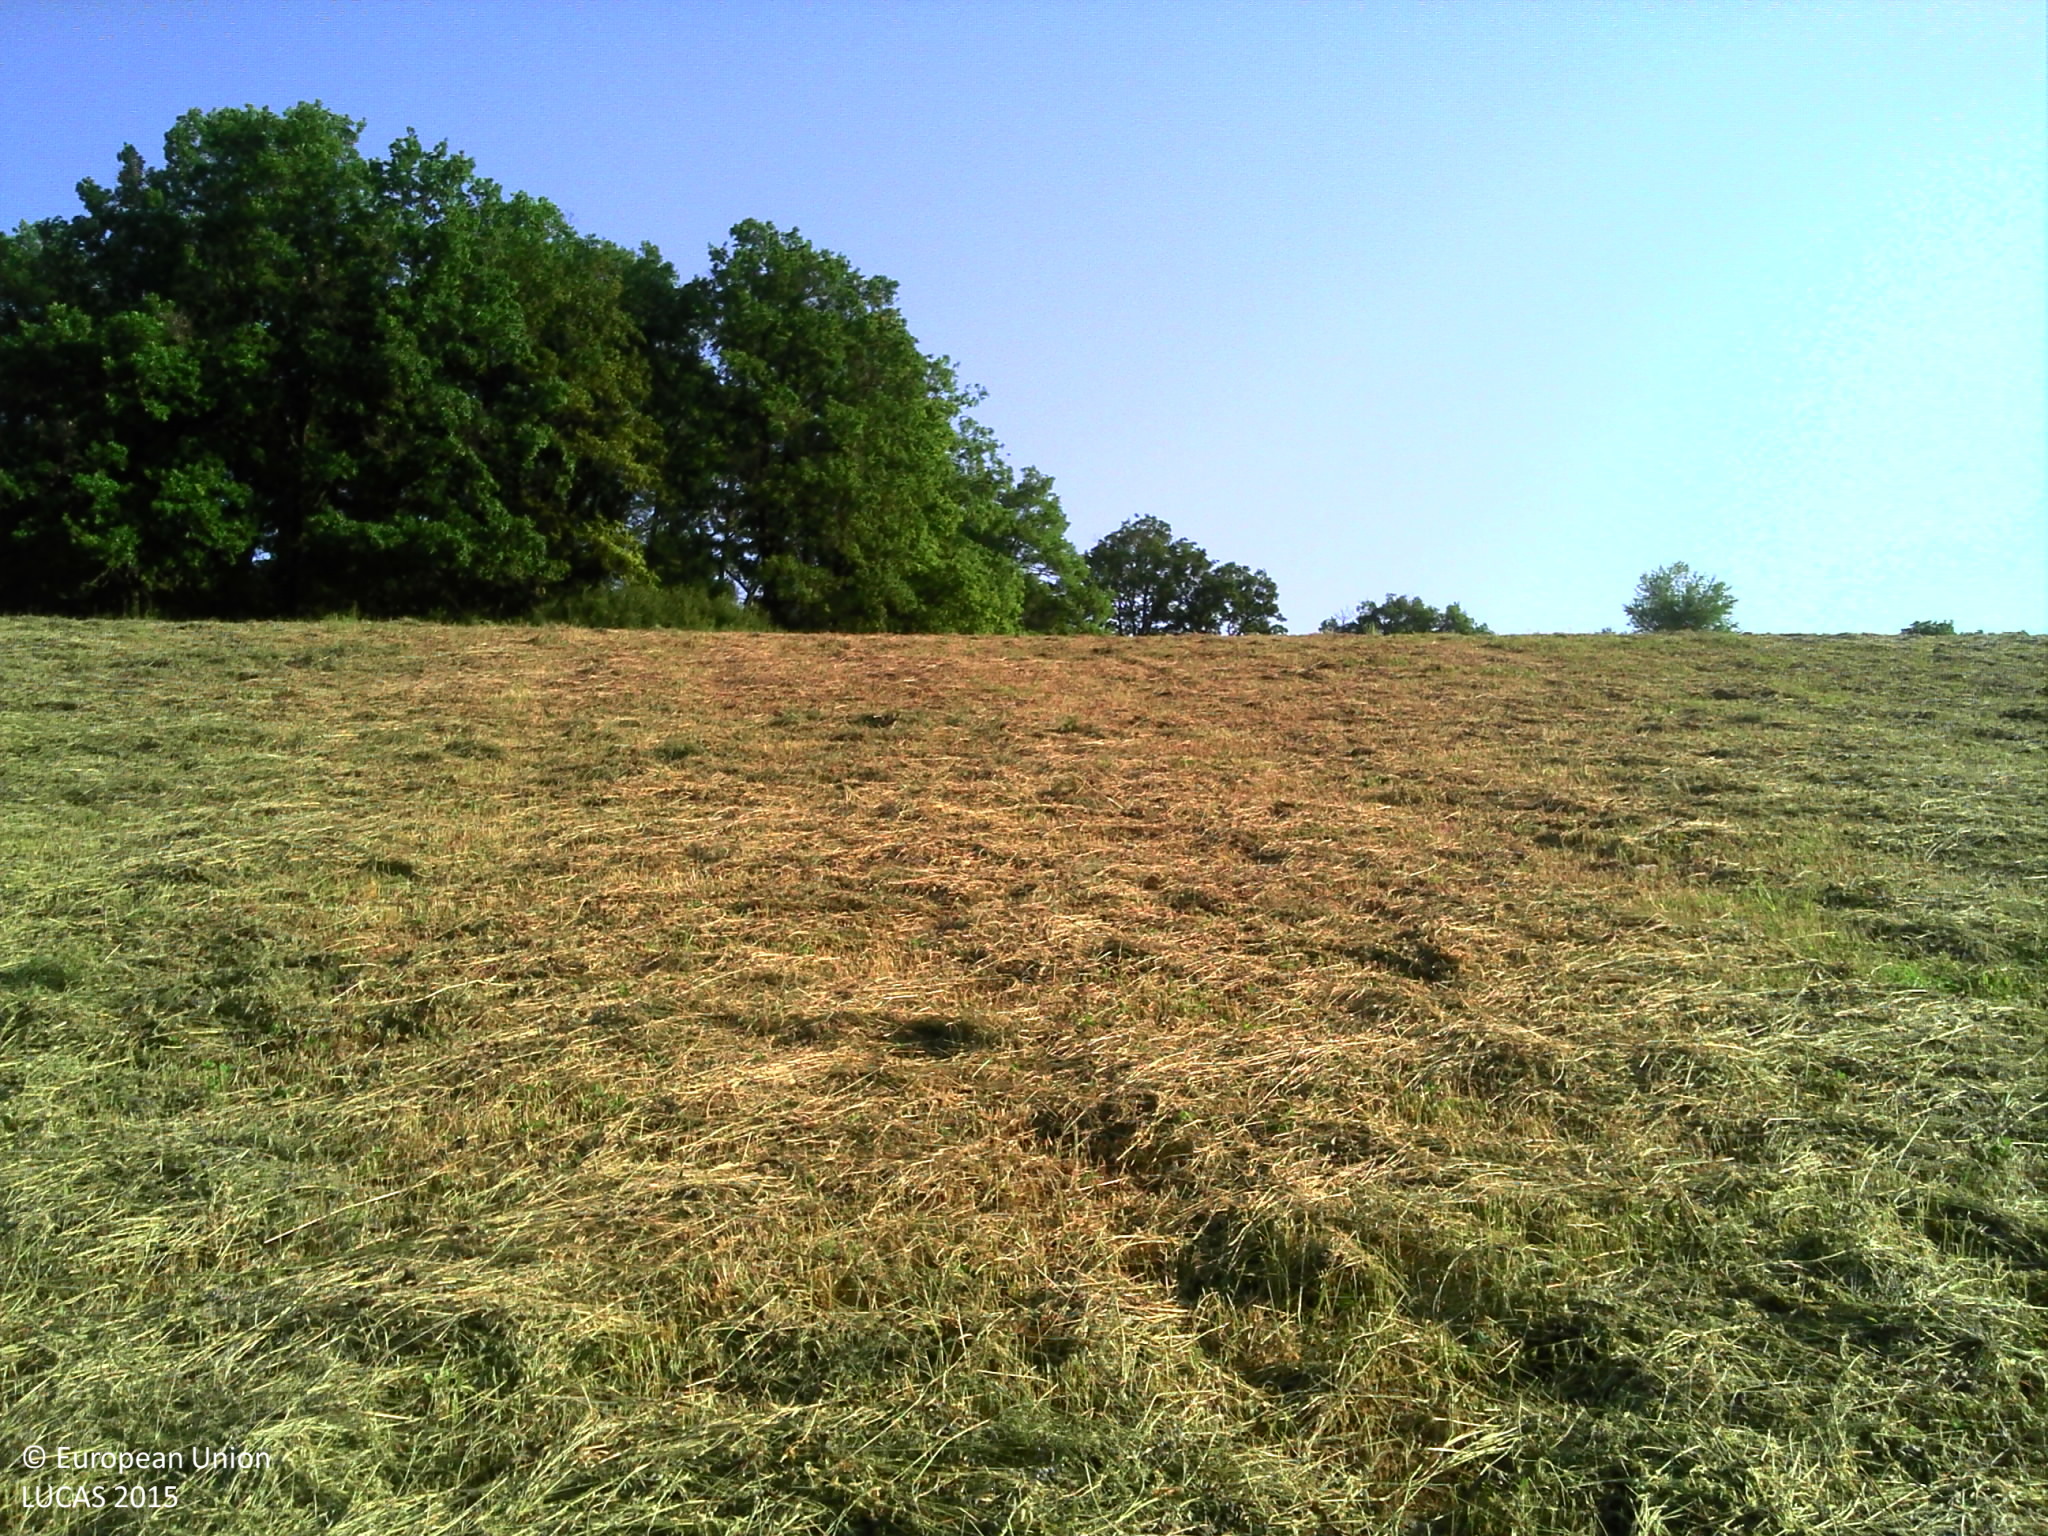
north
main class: Cropland
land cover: Other leguminous and mixtures for fodder
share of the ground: > 75 %
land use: Agriculture (excluding fallow land and kitchen gardens)
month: June
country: FR
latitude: 47.6553
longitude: 3.8591
